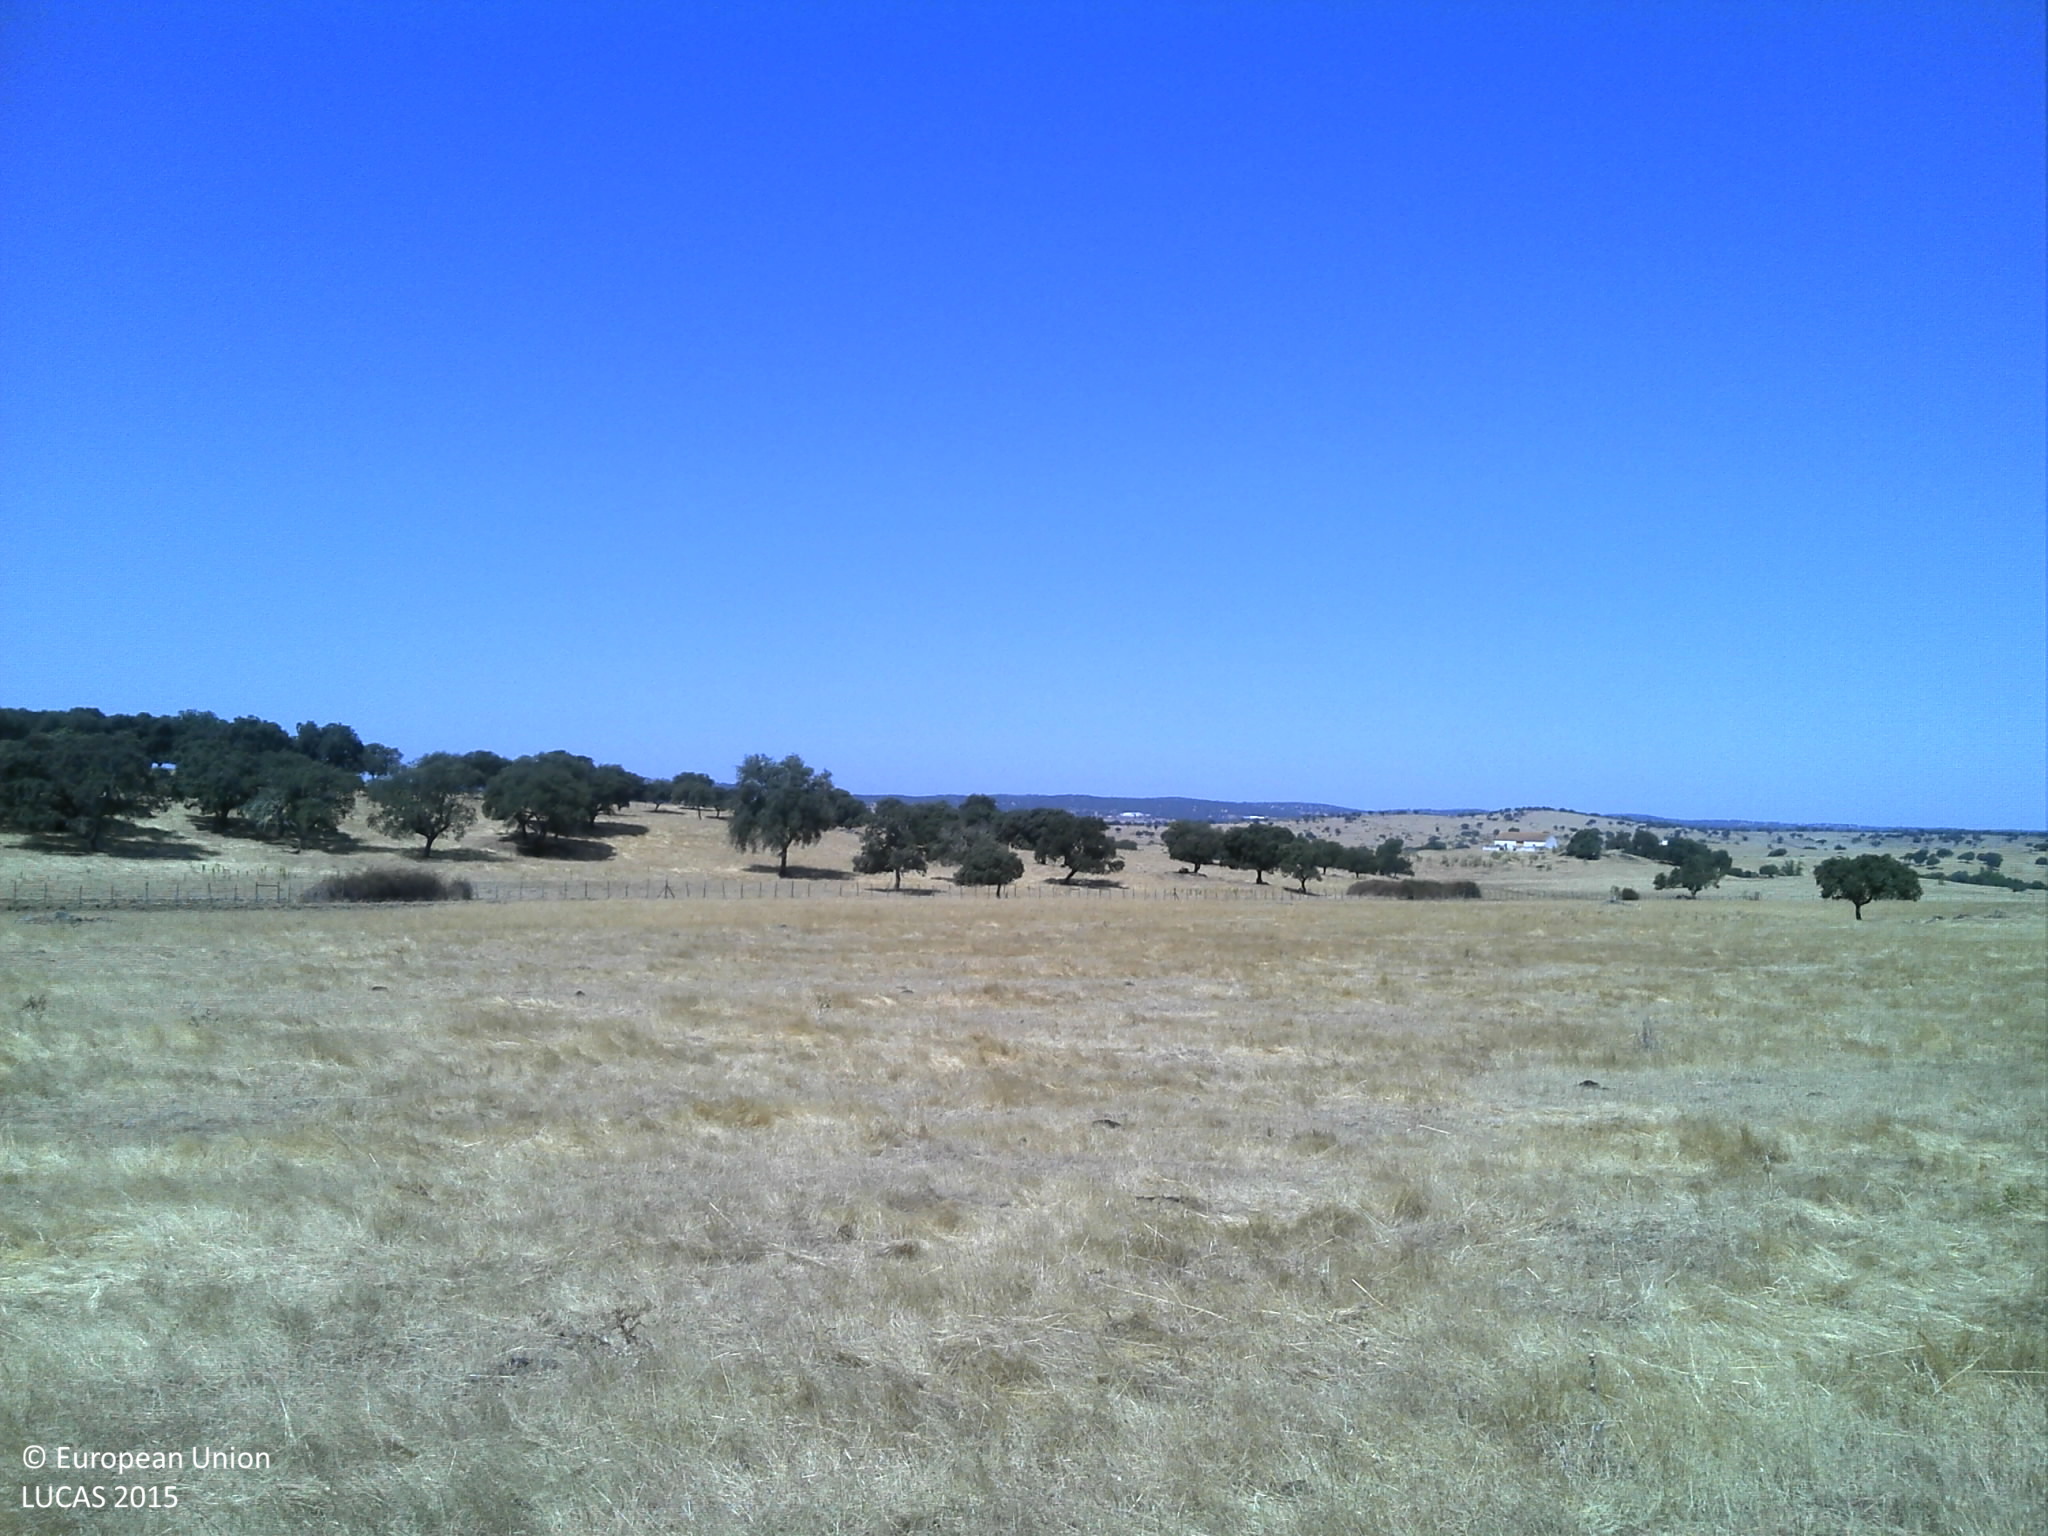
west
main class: Grassland
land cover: Grassland without tree/shrub cover
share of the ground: 50 - 75 %
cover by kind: herbaceous plants 60 %, unconsolidated bare surface 40 %
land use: Agriculture (excluding fallow land and kitchen gardens)
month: July
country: PT
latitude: 39.1195
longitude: -7.4221
